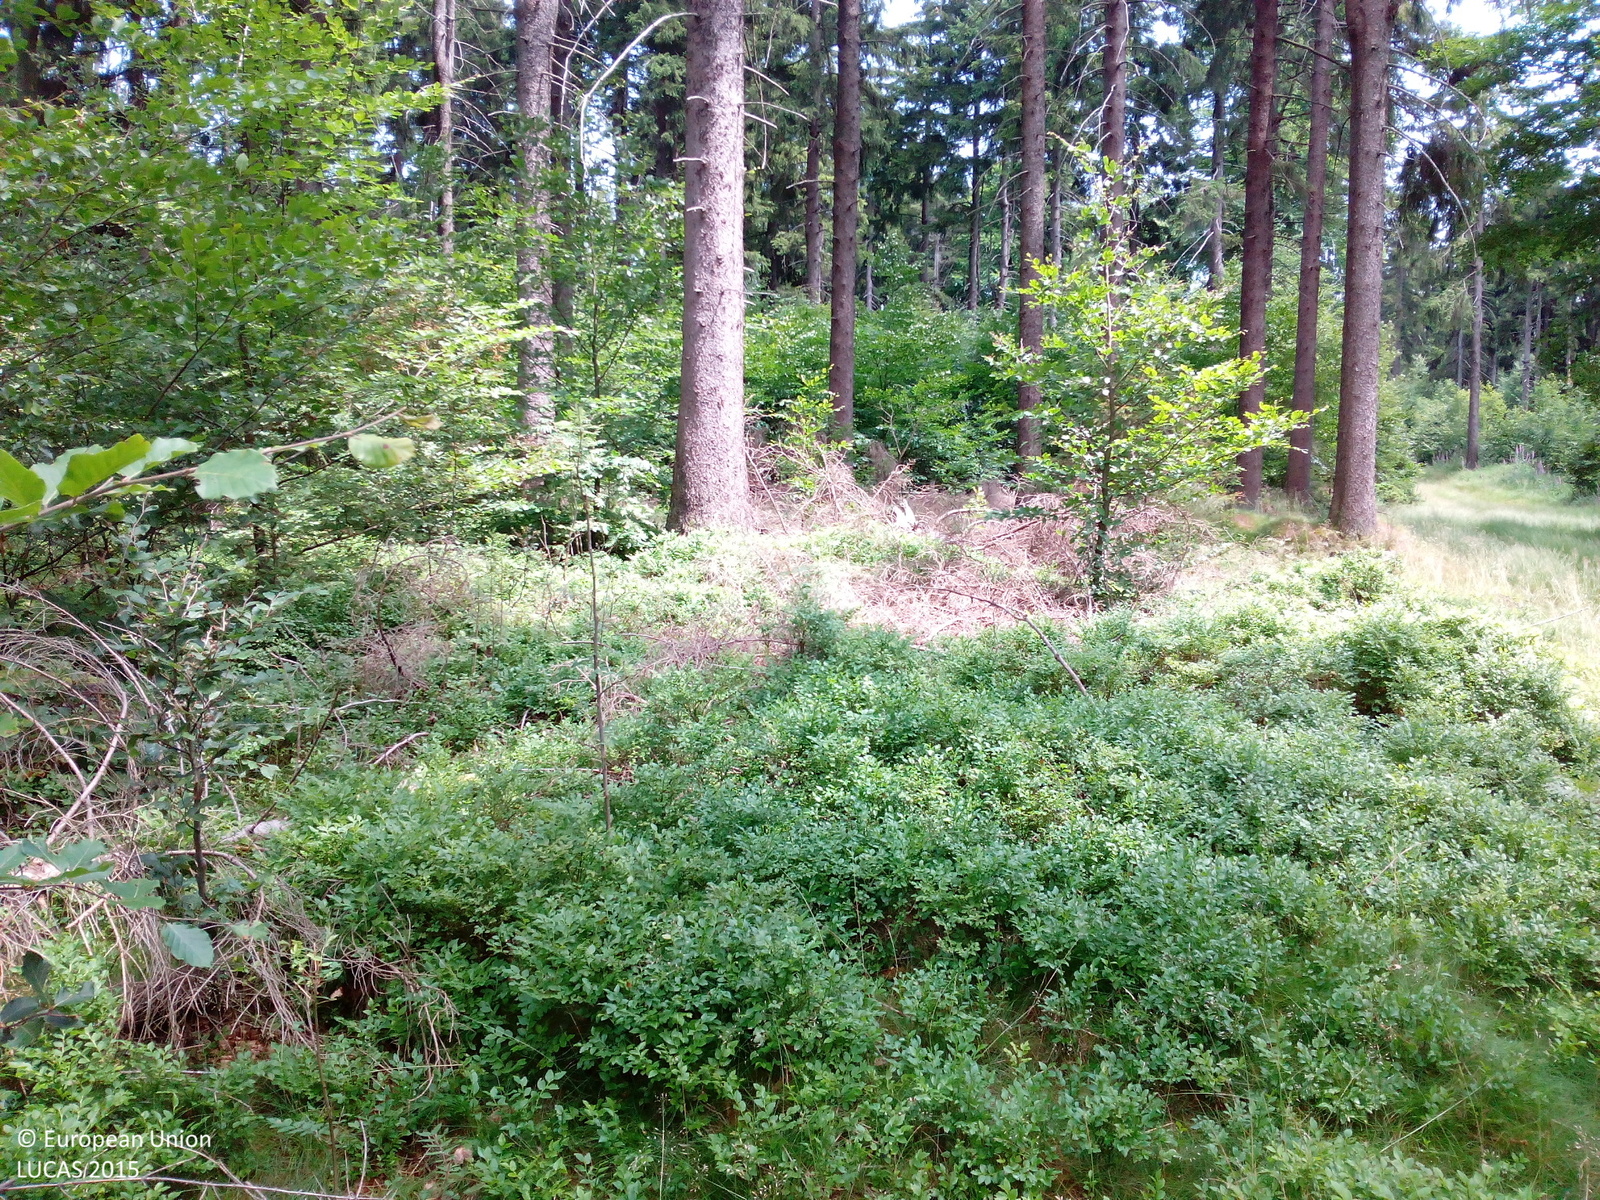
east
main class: Woodland
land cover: Spruce dominated mixed woodland
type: hemiboreal forest and nemoral coniferous forest and mixed broadleaved-coniferous forest
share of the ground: > 75 %
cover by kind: coniferous forest trees 60 %, broadleaved forest trees 25 %, shrubs 5 %, herbaceous plants 5 %, lichens and mosses 5 %
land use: Forestry
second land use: Amenities, museums, leisure
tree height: > 5 m
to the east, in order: Spruce dominated mixed woodland; Grassland without tree/shrub cover; Tracks; Grass margins; Spruce dominated mixed woodland
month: July
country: DE
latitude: 49.7452
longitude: 12.4004
